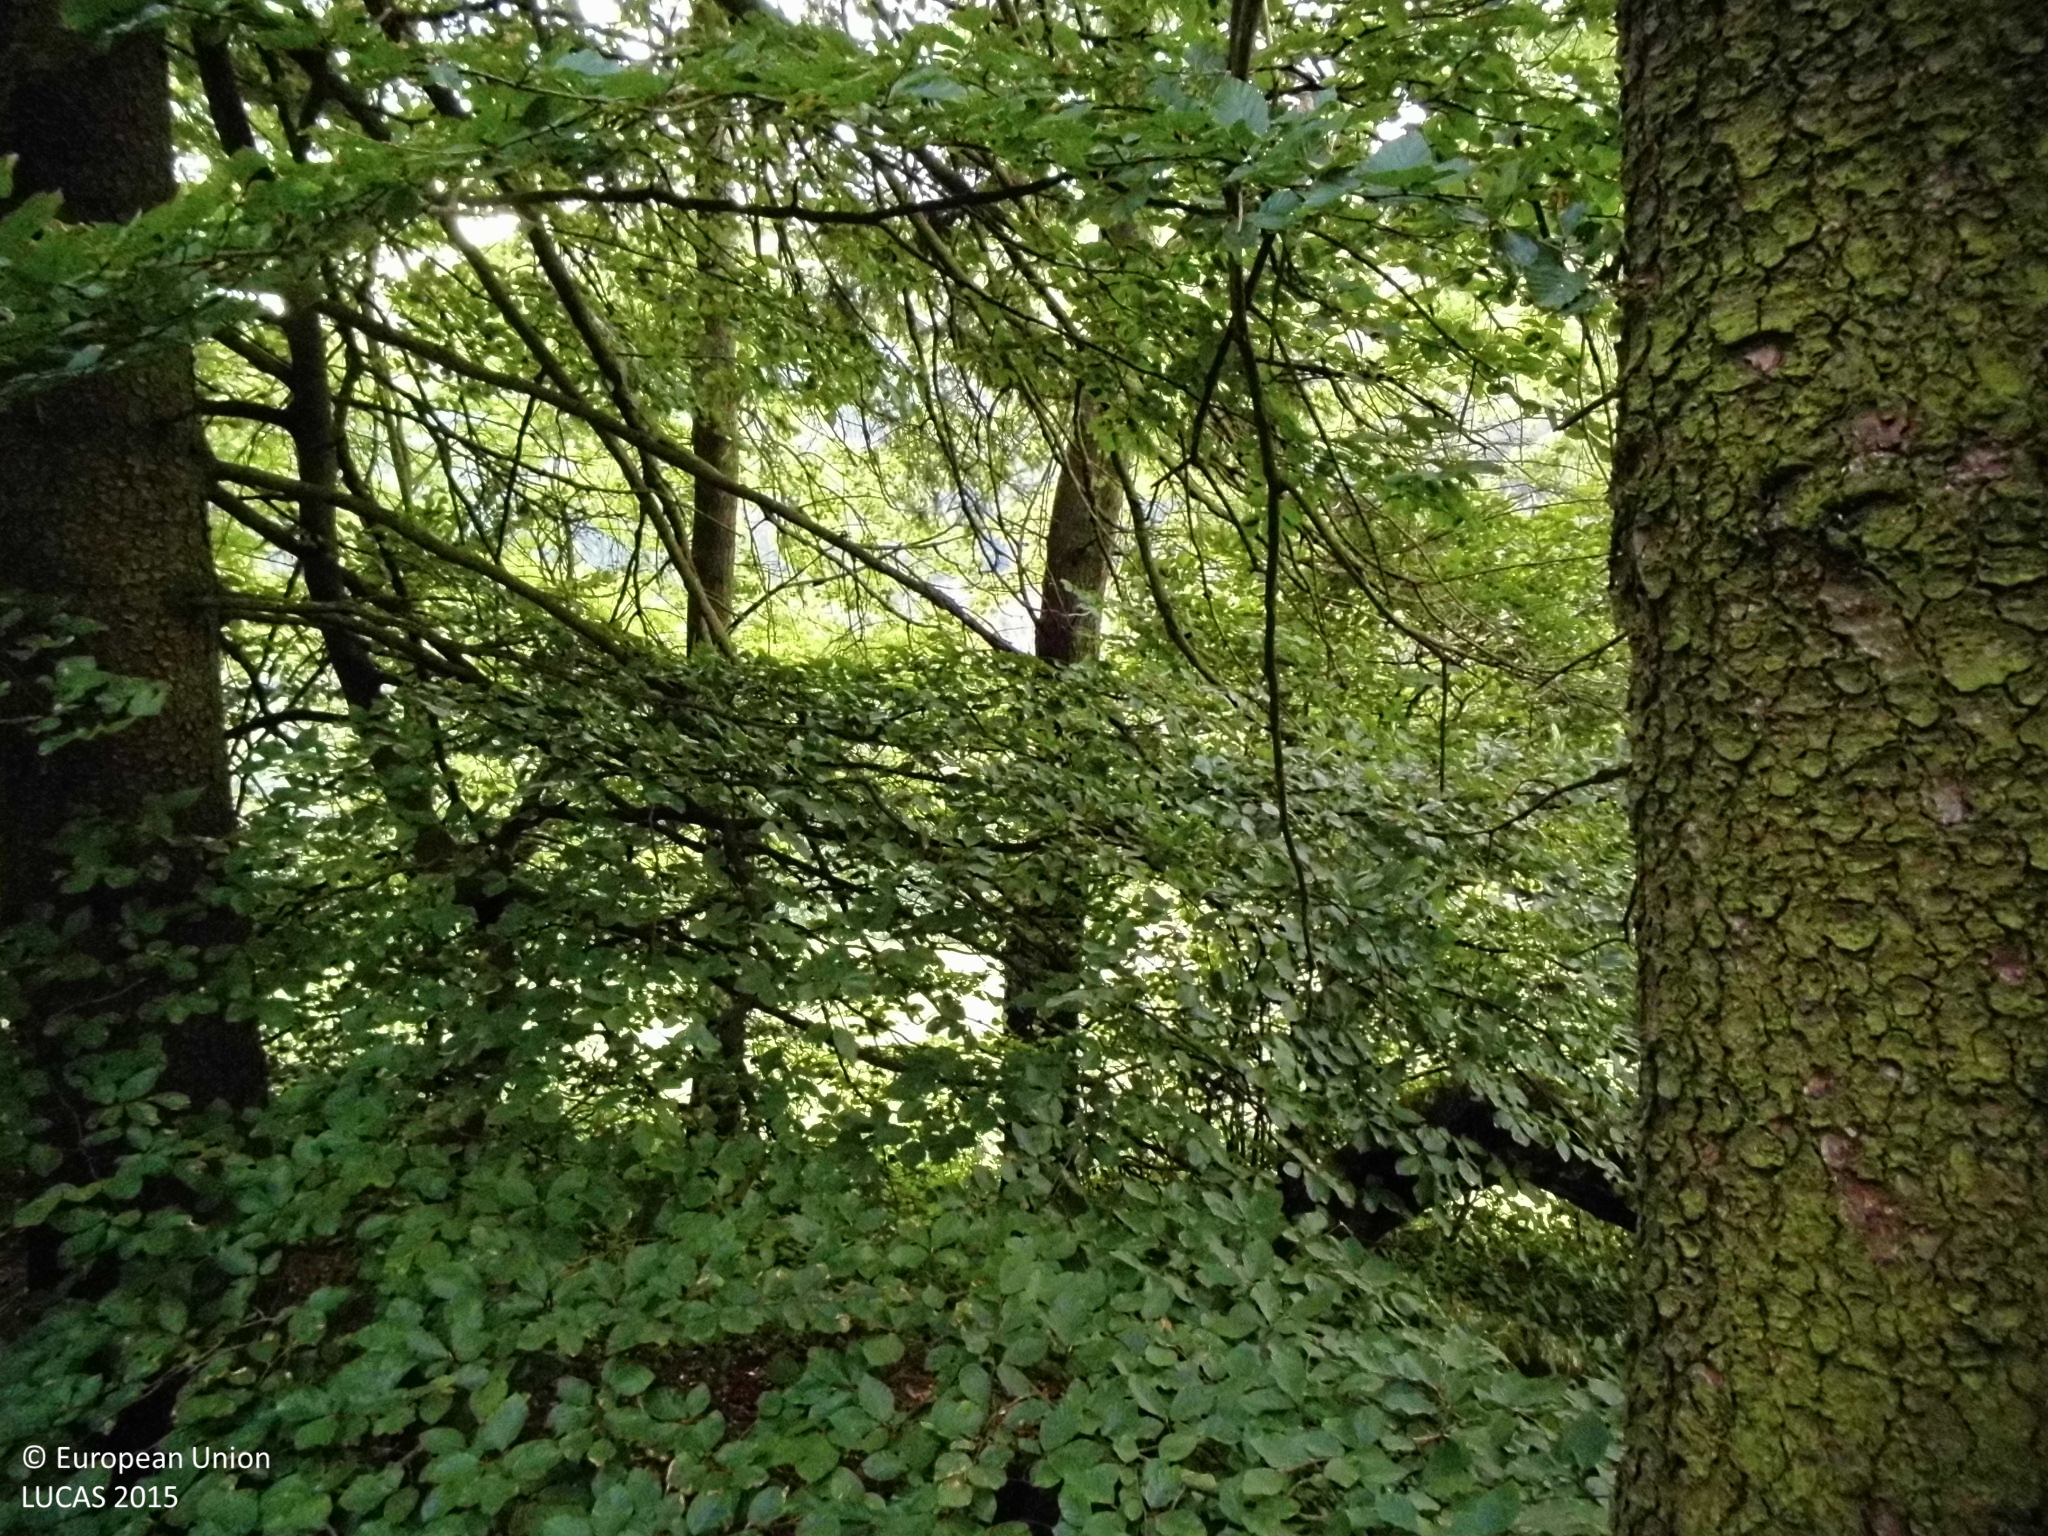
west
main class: Woodland
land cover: Spruce dominated coniferous woodland
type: hemiboreal forest and nemoral coniferous forest and mixed broadleaved-coniferous forest
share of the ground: > 75 %
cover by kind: coniferous forest trees 75 %, shrubs 10 %, herbaceous plants 10 %, broadleaved forest trees 5 %
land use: Forestry
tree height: > 5 m
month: September
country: DE
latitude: 51.2349
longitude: 8.4679
